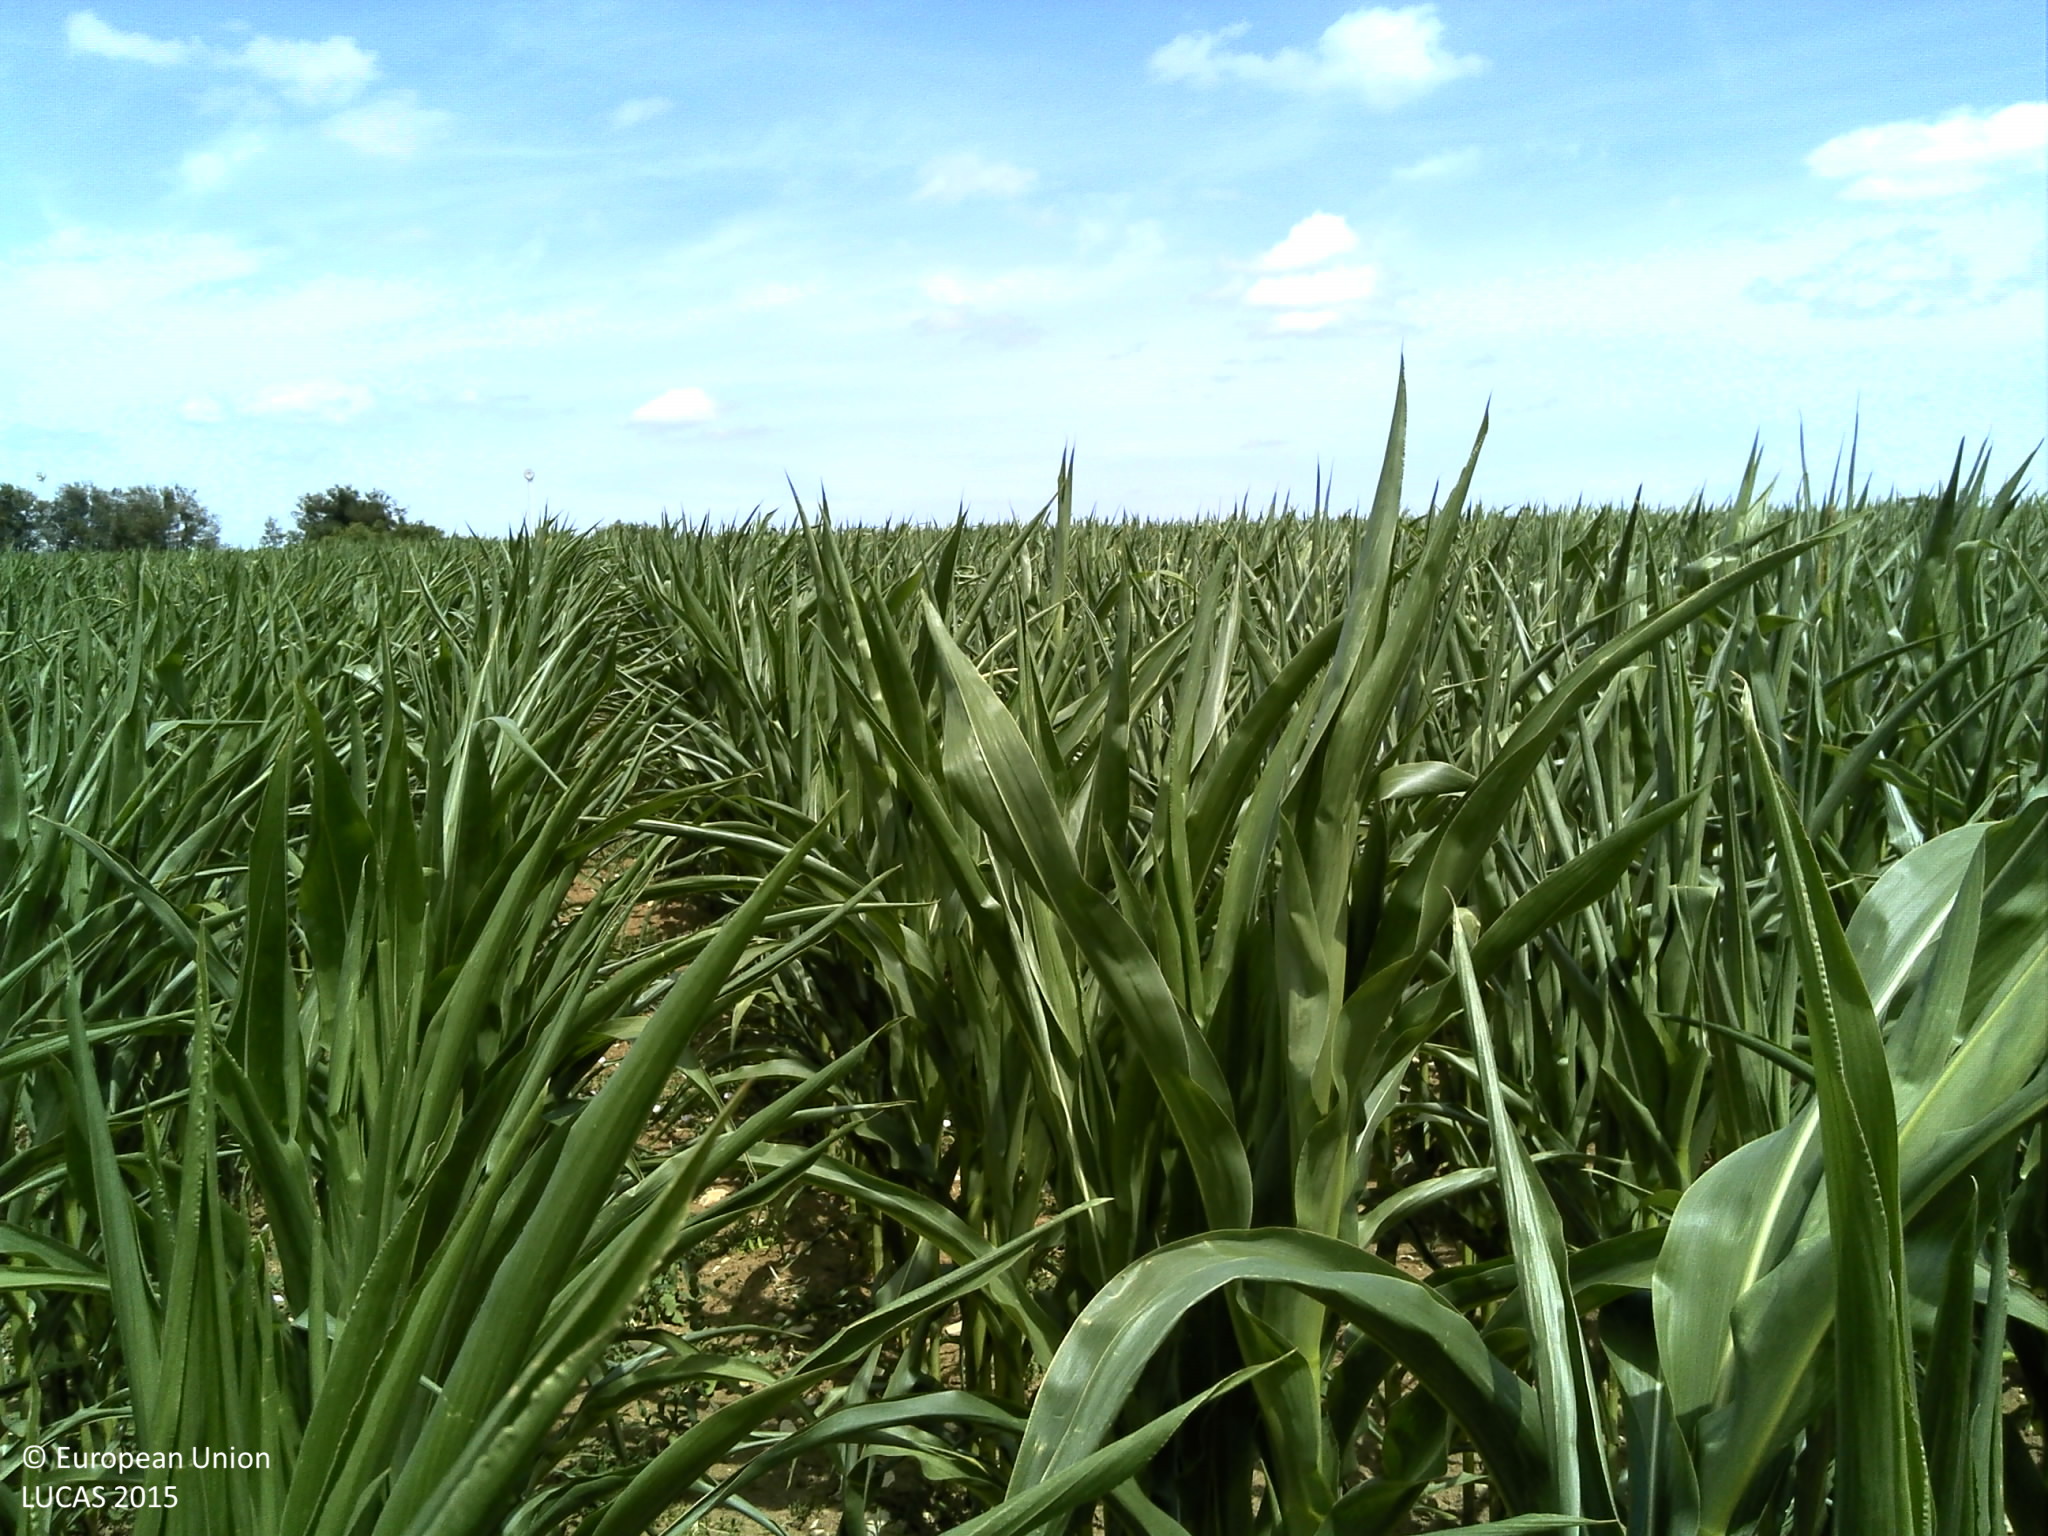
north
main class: Cropland
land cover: Maize
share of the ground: > 75 %
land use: Agriculture (excluding fallow land and kitchen gardens)
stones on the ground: 10 - 25 %
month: July
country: FR
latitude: 48.3663
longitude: 6.5045
